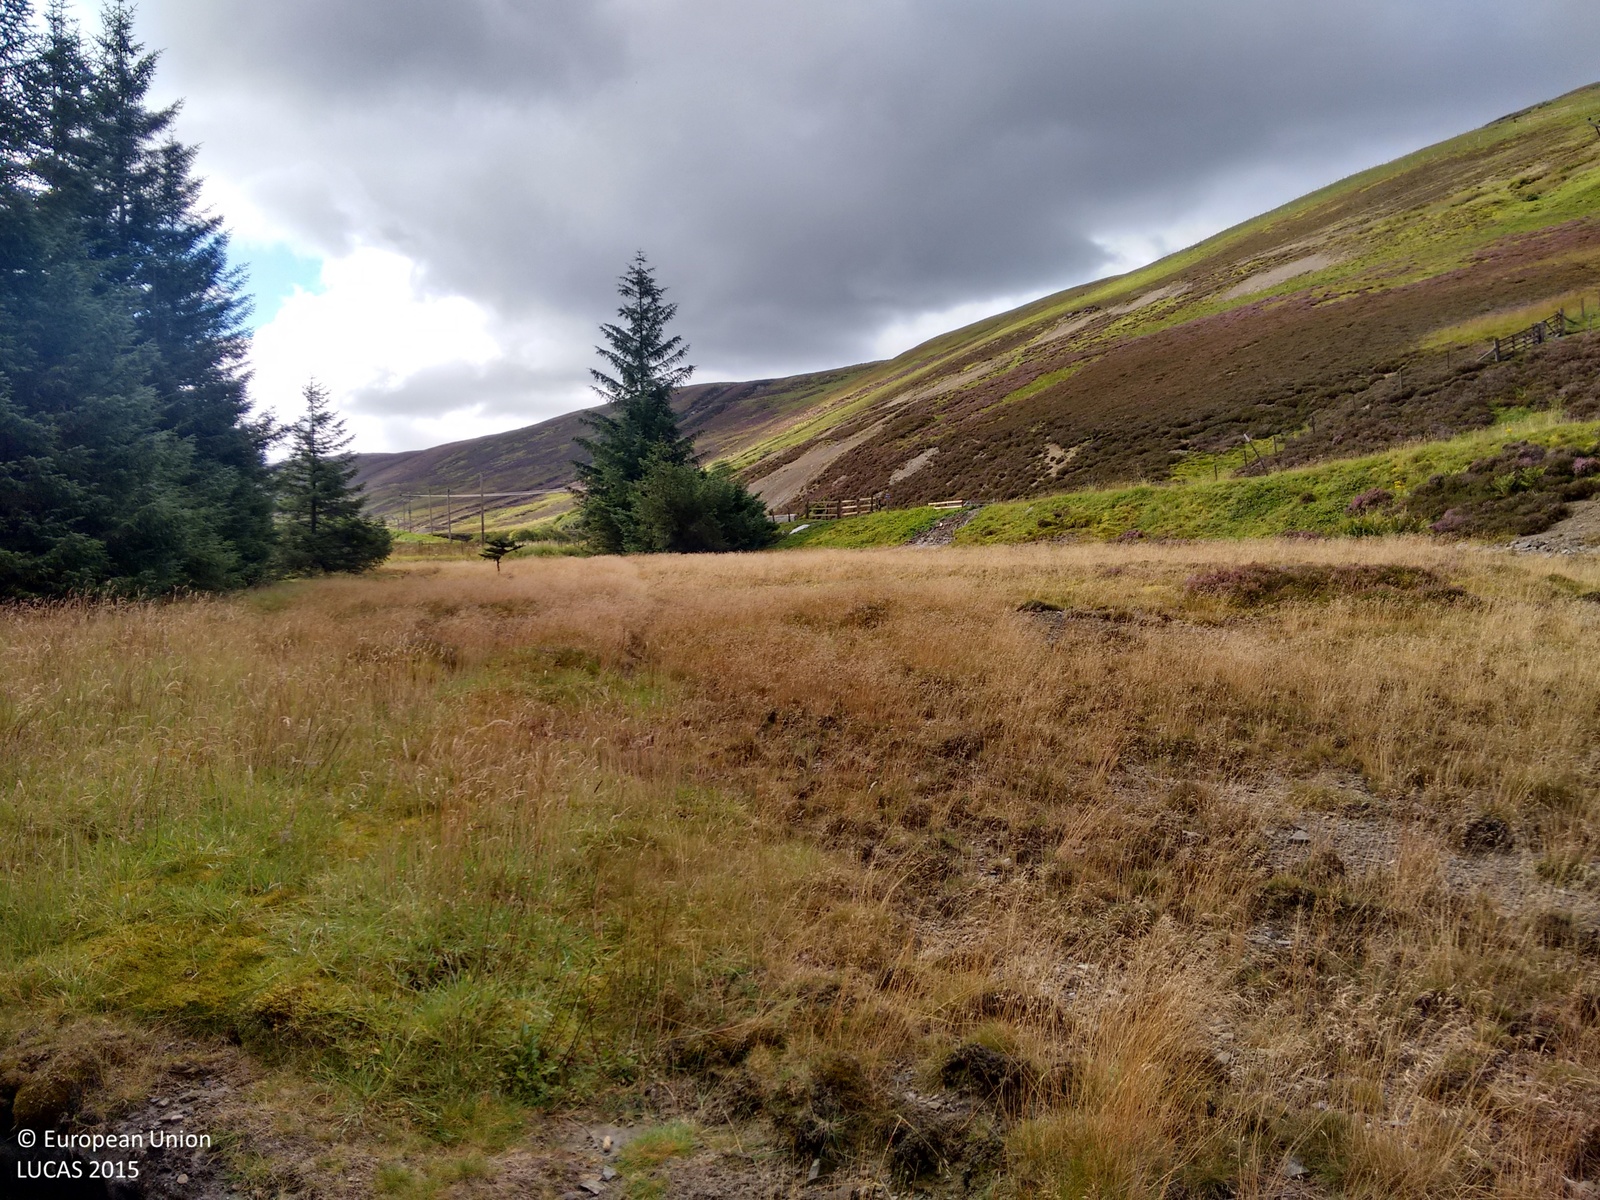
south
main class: Woodland
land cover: Spruce dominated coniferous woodland
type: exotic forest
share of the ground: > 75 %
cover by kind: coniferous forest trees 95 %, lichens and mosses 5 %
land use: Forestry
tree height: > 5 m
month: September
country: GB
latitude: 55.4419
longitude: -3.7578
